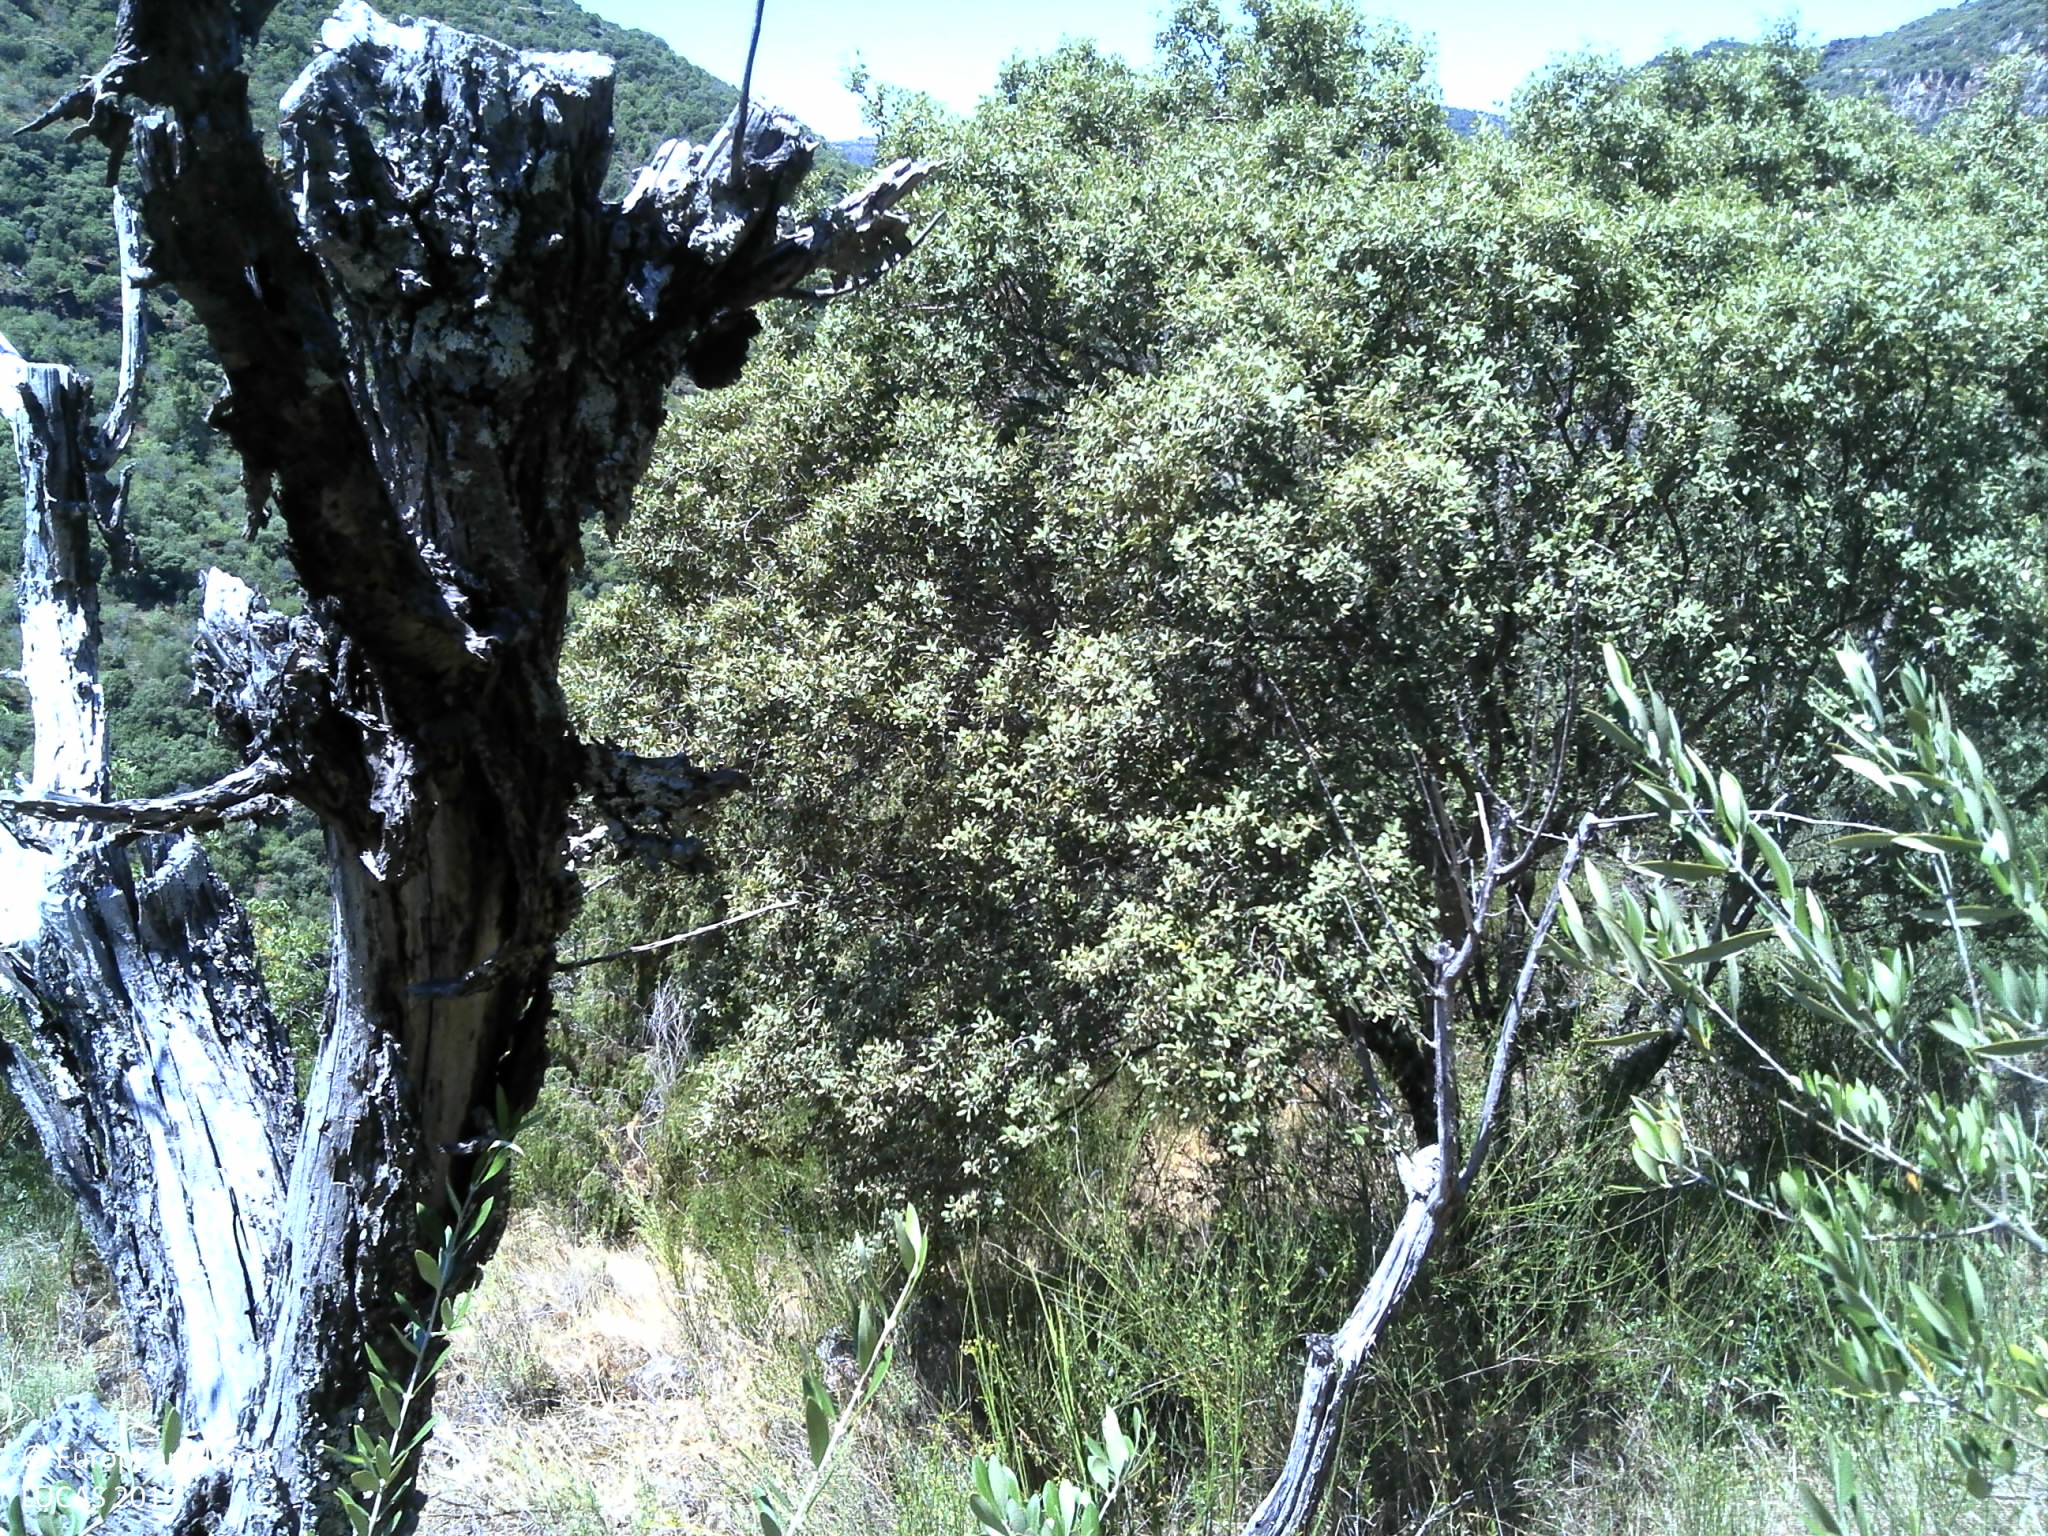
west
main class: Shrubland
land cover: Shrubland with sparse tree cover
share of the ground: 50 - 75 %
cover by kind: shrubs 75 %, unconsolidated bare surface 15 %, broadleaved forest trees 5 %, herbaceous plants 5 %
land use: Abandoned areas
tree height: > 5 m
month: June
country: PT
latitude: 41.2880
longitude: -6.8362
